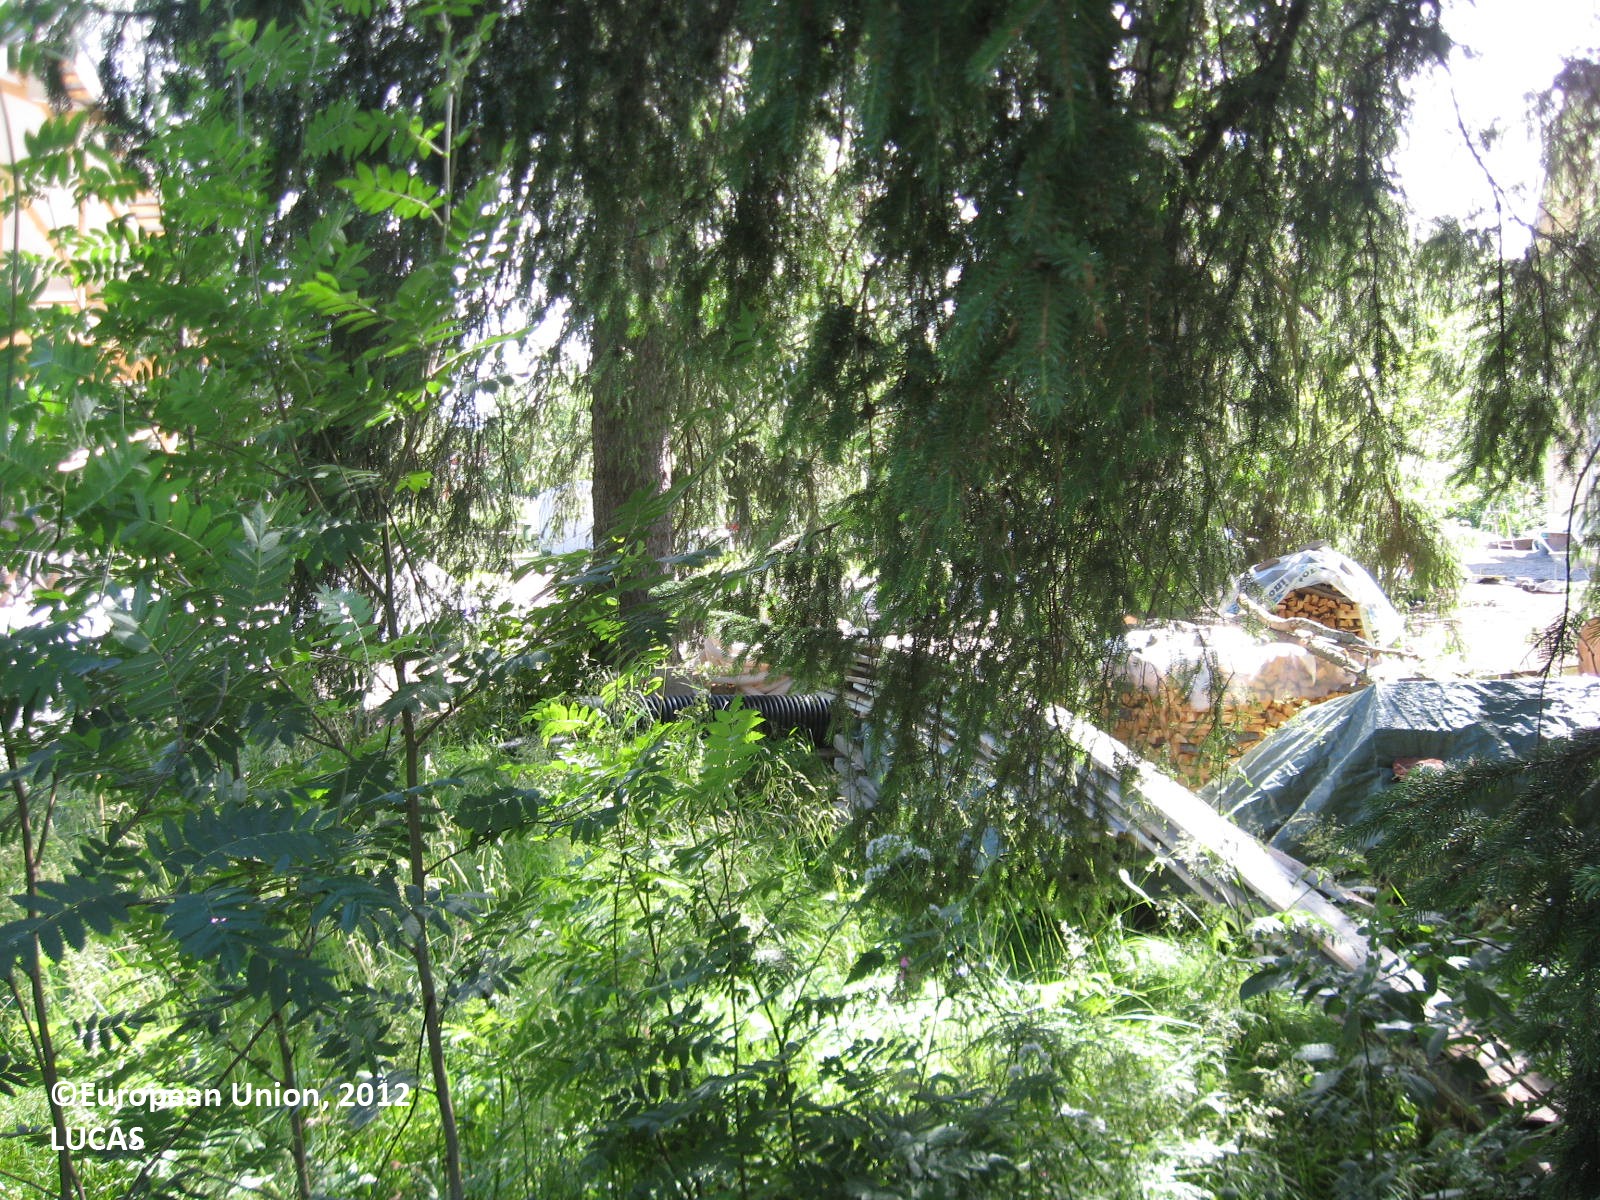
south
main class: Woodland
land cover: Other mixed woodland
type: boreal forest
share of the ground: > 75 %
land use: Community services
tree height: > 5 m
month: July
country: FI
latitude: 62.2700
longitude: 21.3906
